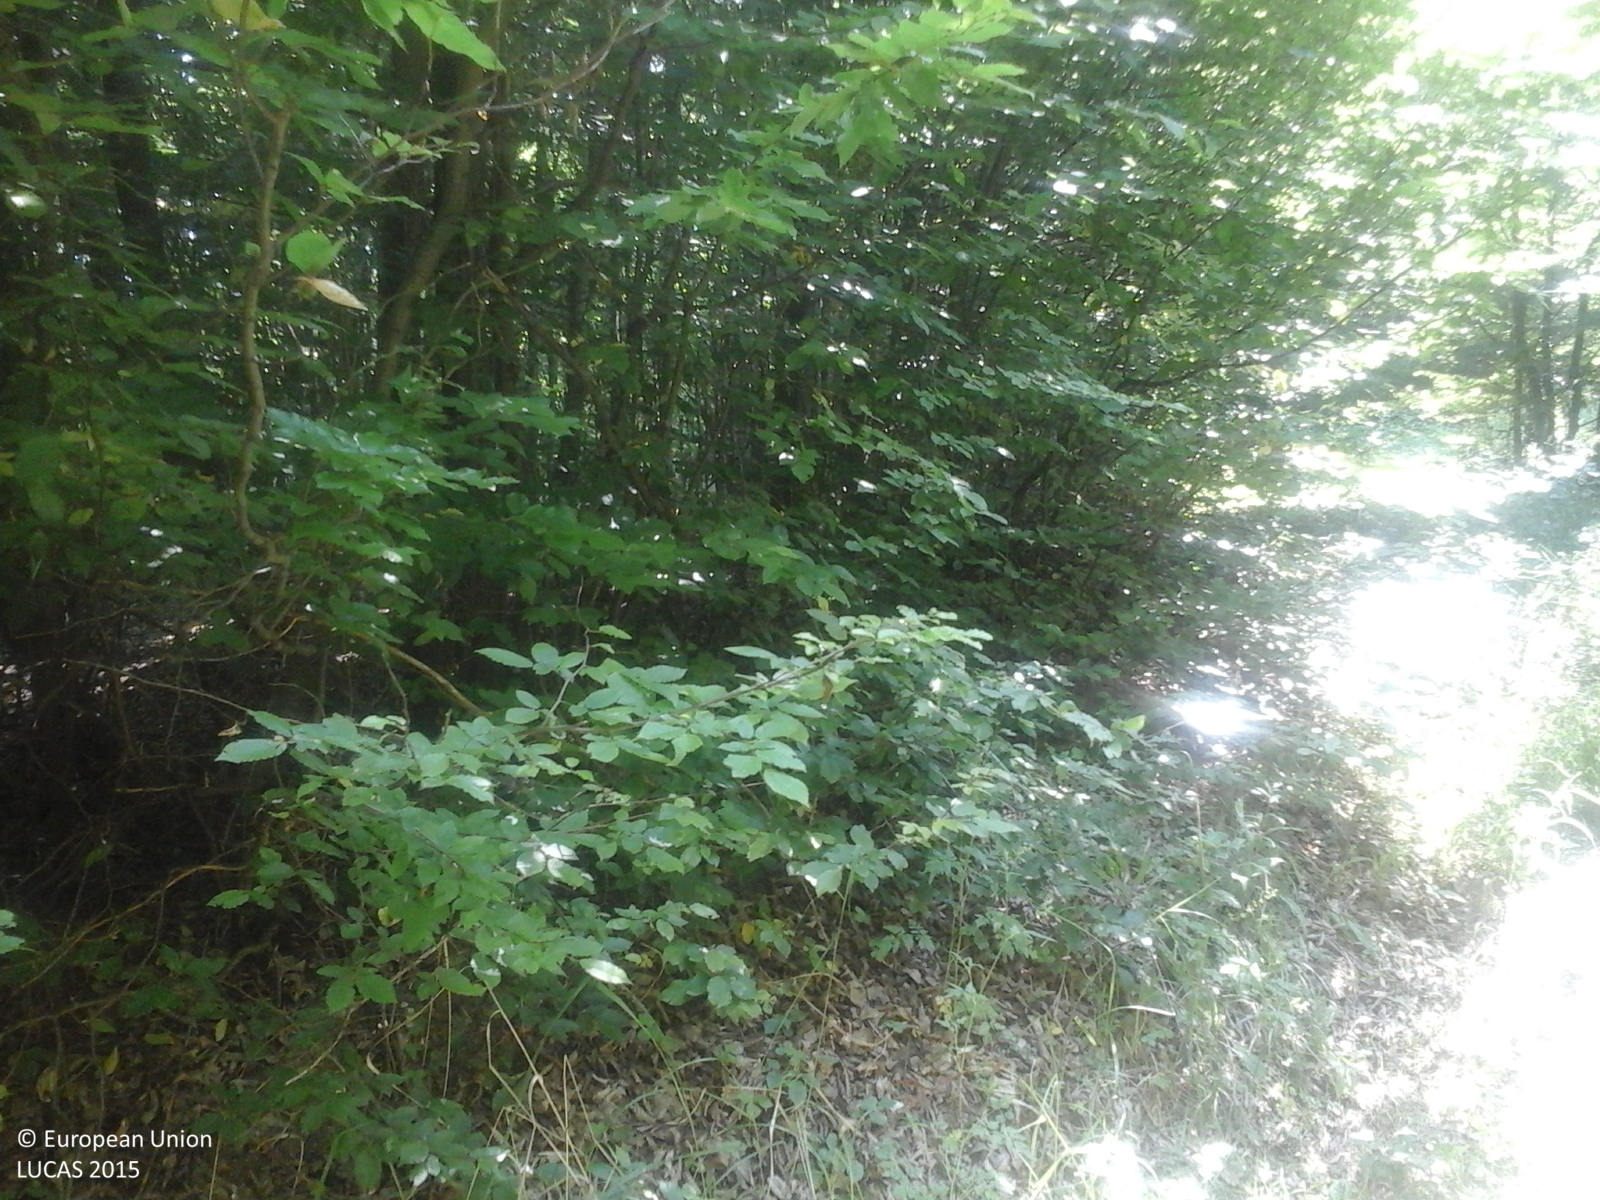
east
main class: Woodland
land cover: Broadleaved woodland
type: beech forest
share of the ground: > 75 %
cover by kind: broadleaved forest trees 95 %, herbaceous plants 5 %
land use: Forestry
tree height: > 5 m
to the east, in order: Broadleaved woodland; Tracks; Broadleaved woodland; Ditches and canals; Broadleaved woodland
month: July
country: RO
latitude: 44.9415
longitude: 24.3287
